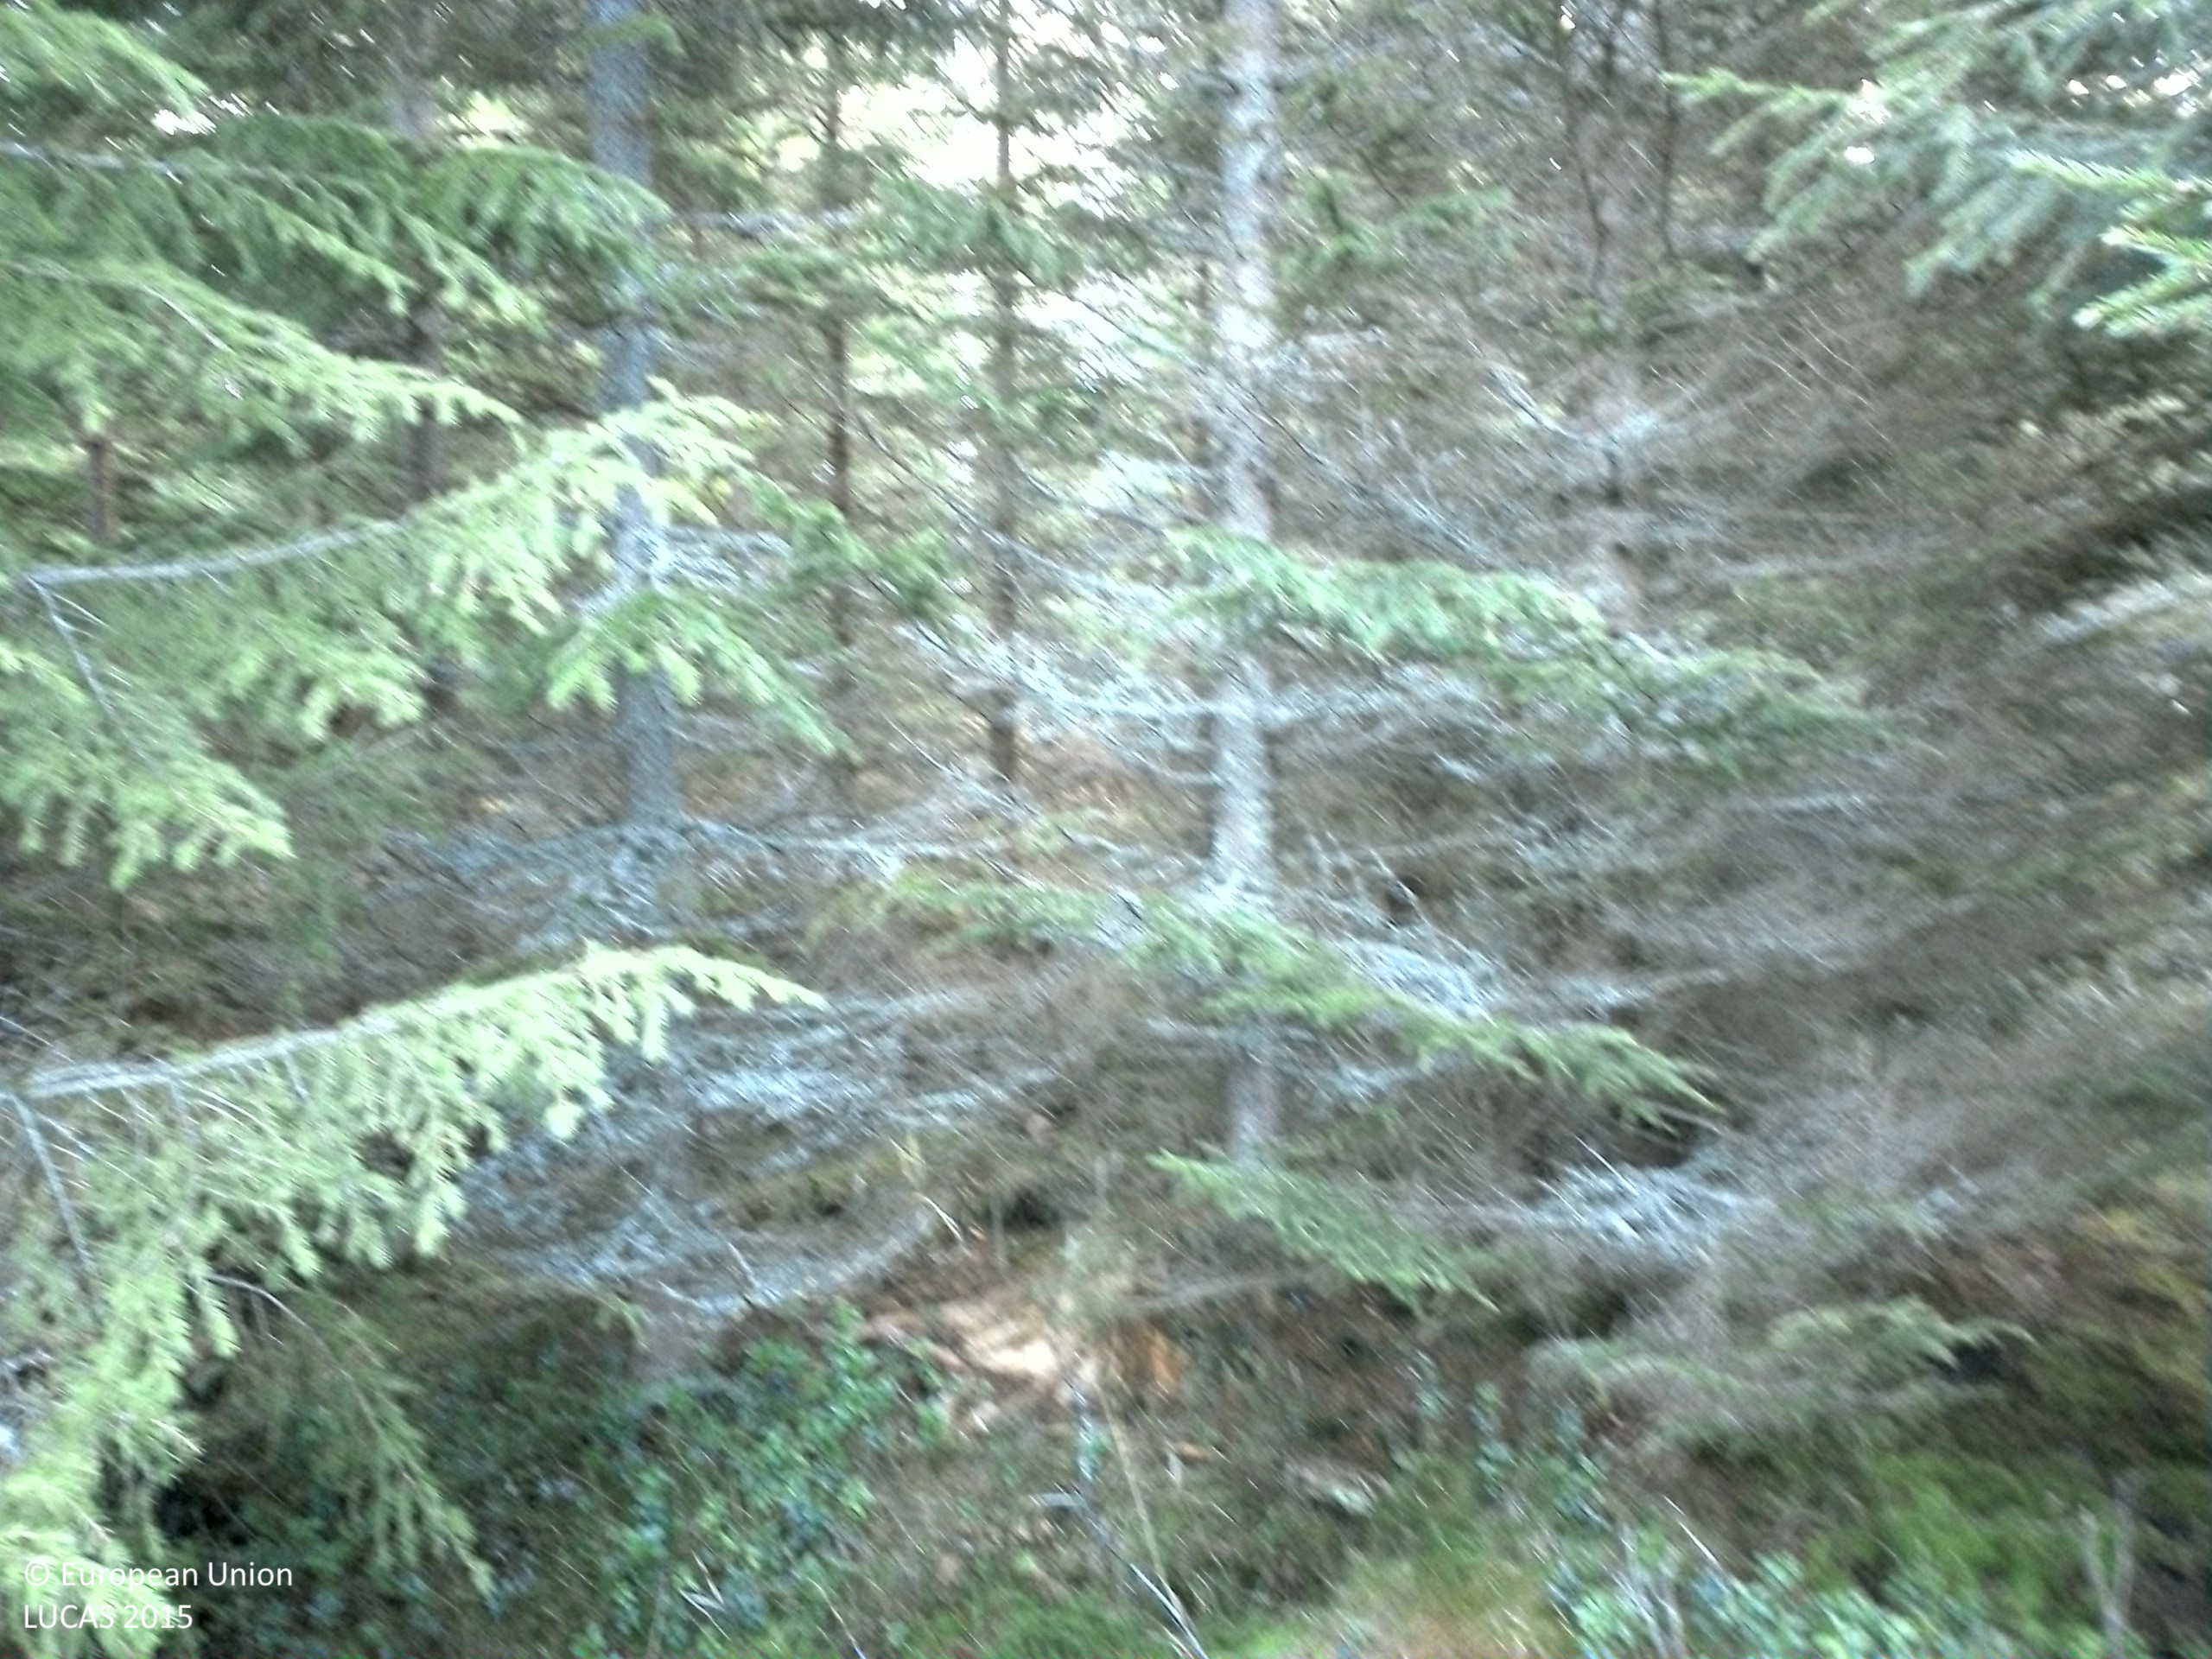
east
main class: Woodland
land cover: Spruce dominated coniferous woodland
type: boreal forest
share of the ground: 50 - 75 %
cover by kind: coniferous forest trees 70 %, herbaceous plants 10 %, lichens and mosses 10 %, broadleaved forest trees 5 %, shrubs 5 %
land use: Forestry
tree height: > 5 m
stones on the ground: < 10 %
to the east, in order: Spruce dominated coniferous woodland; Spruce dominated mixed woodland; Spruce dominated coniferous woodland; Pine dominated coniferous woodland; Other coniferous woodland
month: November
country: SE
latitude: 60.3110
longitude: 14.9298
